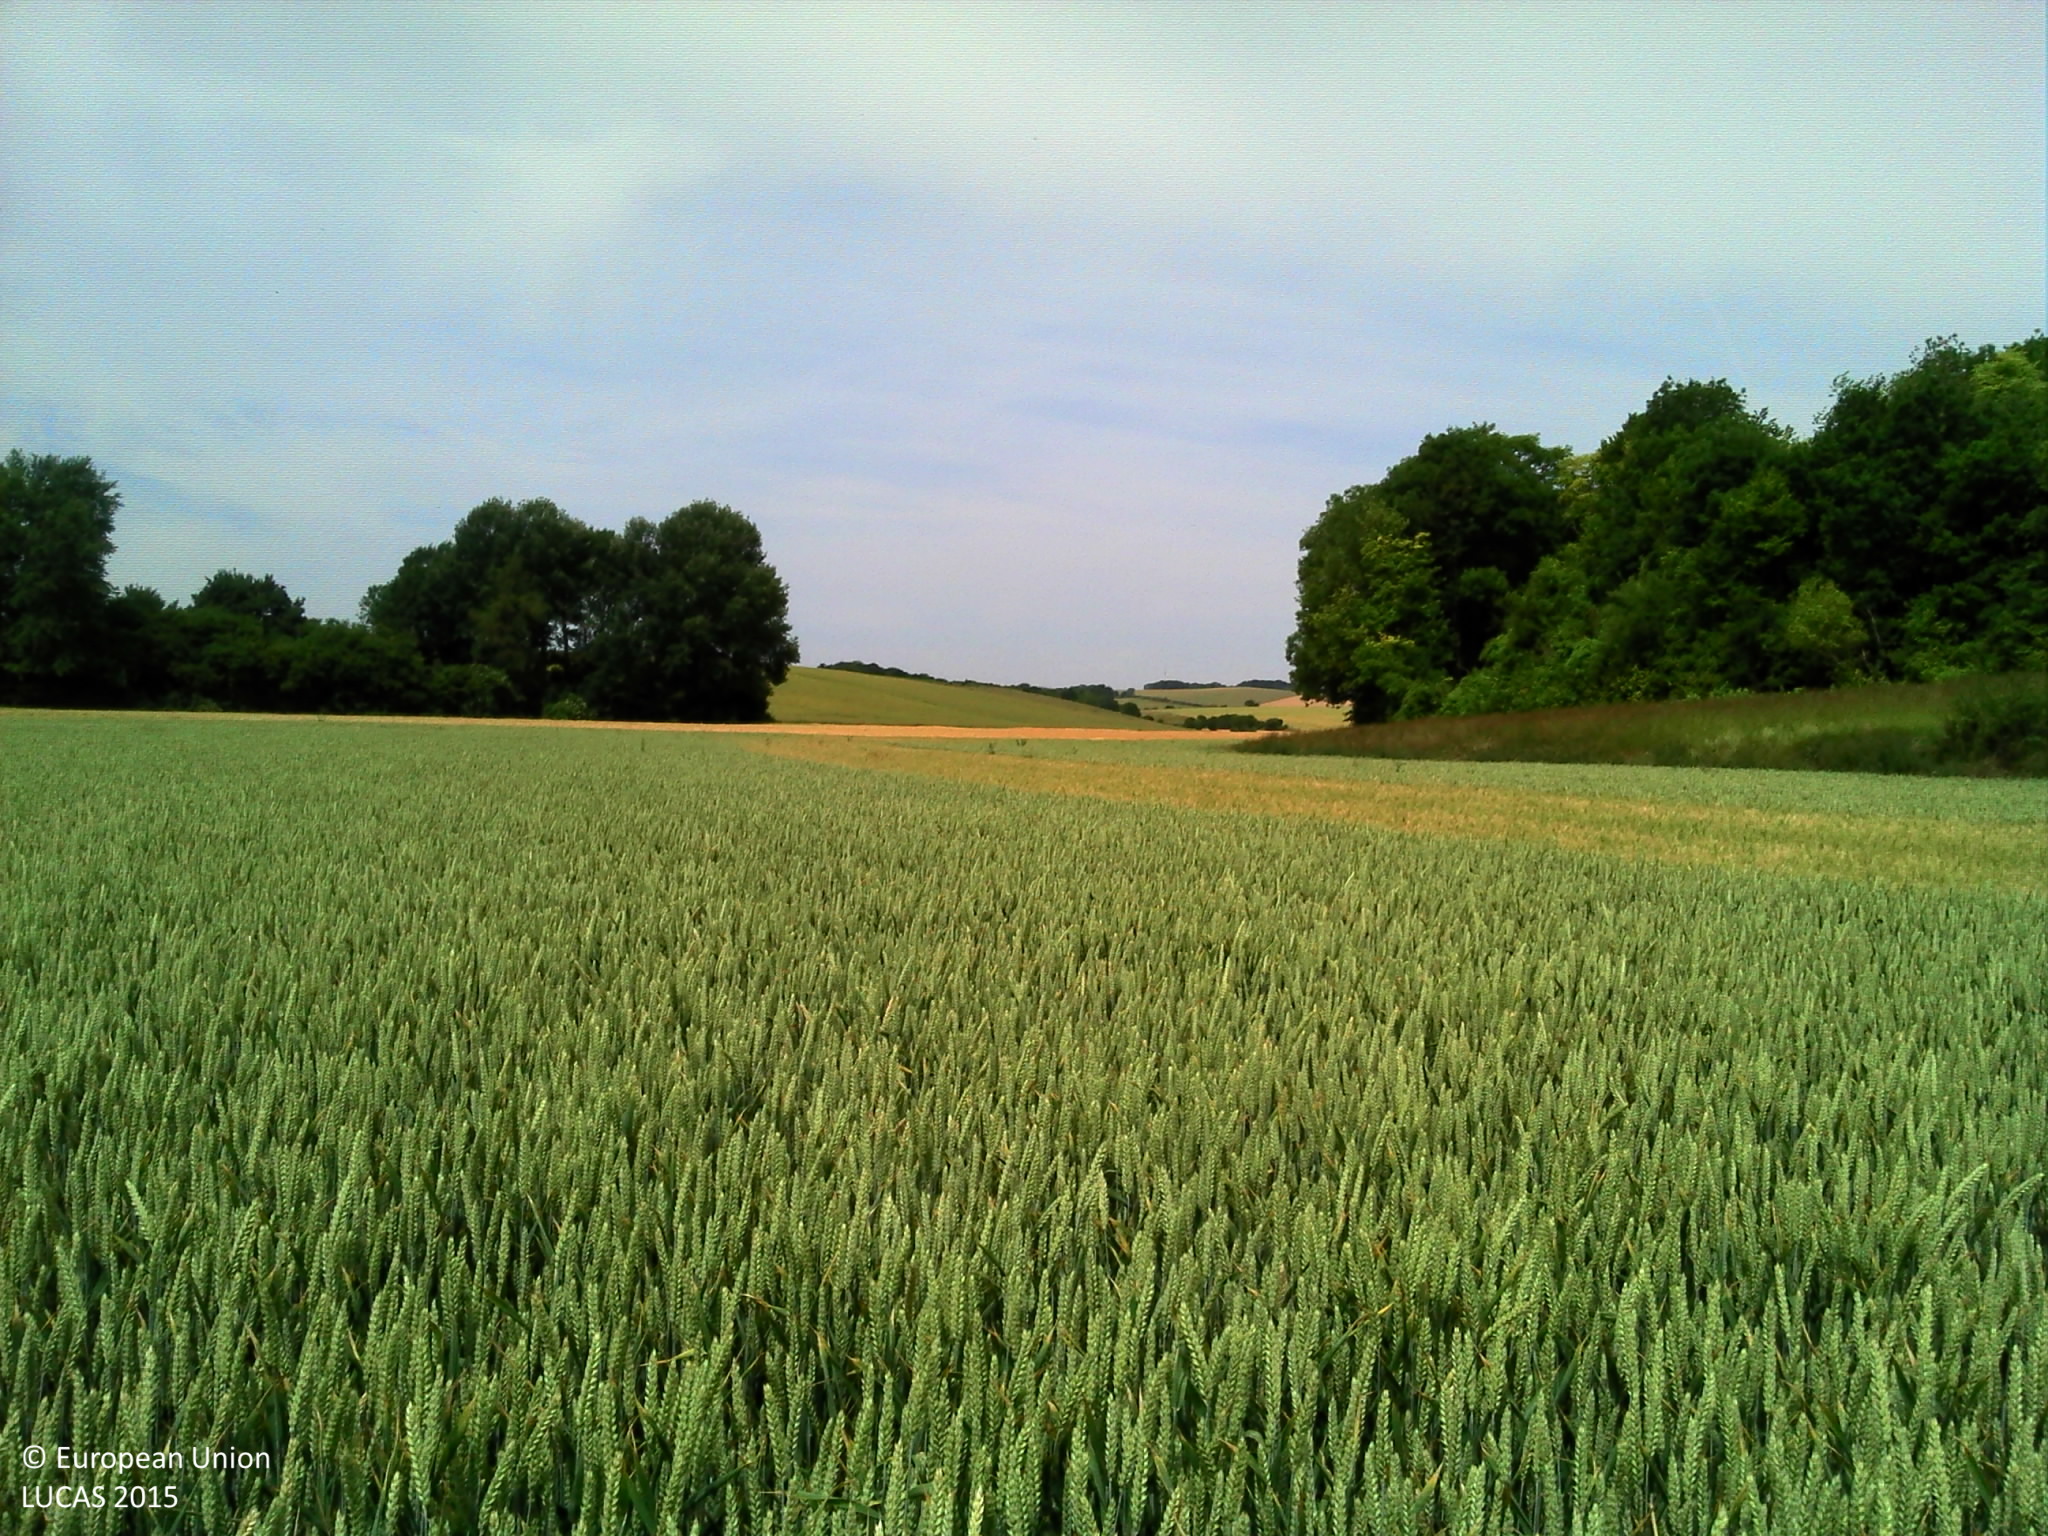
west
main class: Cropland
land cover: Common wheat
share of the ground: > 75 %
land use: Agriculture (excluding fallow land and kitchen gardens)
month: June
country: FR
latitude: 49.6705
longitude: 2.2964
